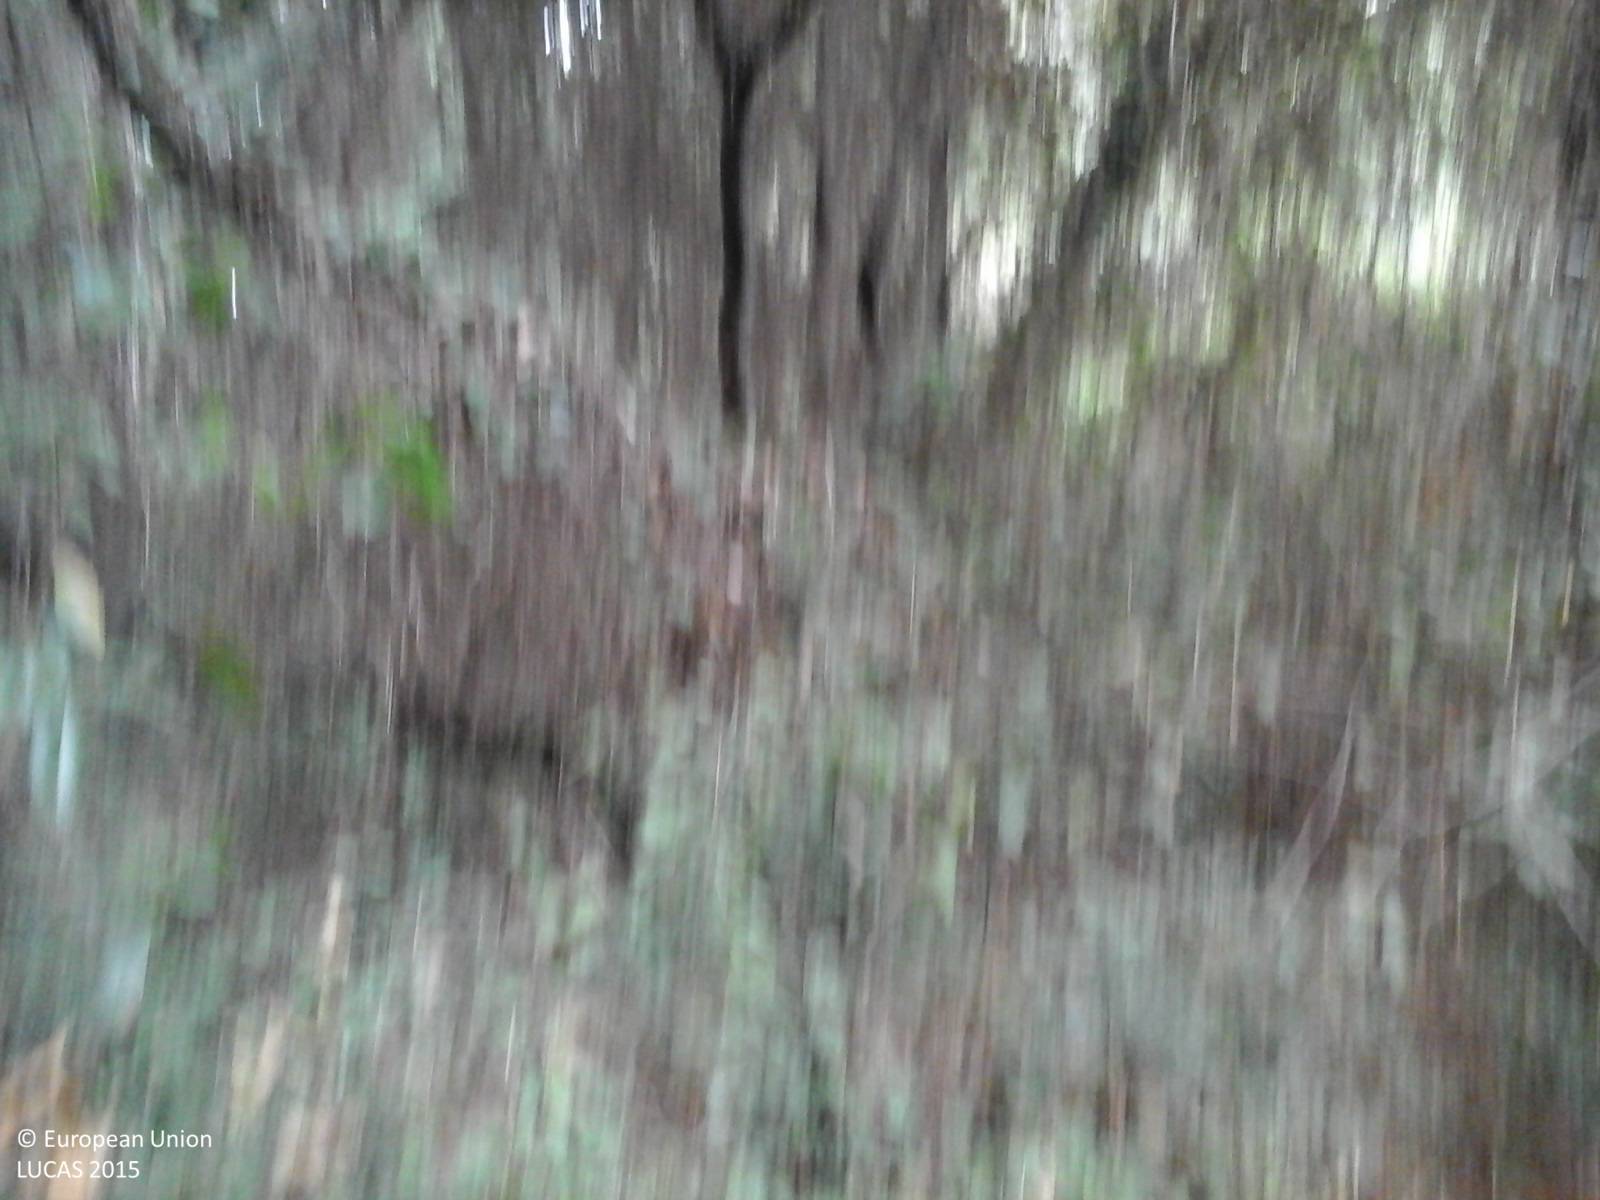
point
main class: Woodland
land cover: Pine dominated mixed woodland
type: coniferous forest of the mediterranean region
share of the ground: > 75 %
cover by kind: coniferous forest trees 65 %, broadleaved forest trees 25 %, shrubs 10 %
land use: Amenities, museums, leisure
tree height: > 5 m
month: July
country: IT
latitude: 41.7239
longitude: 12.3110
